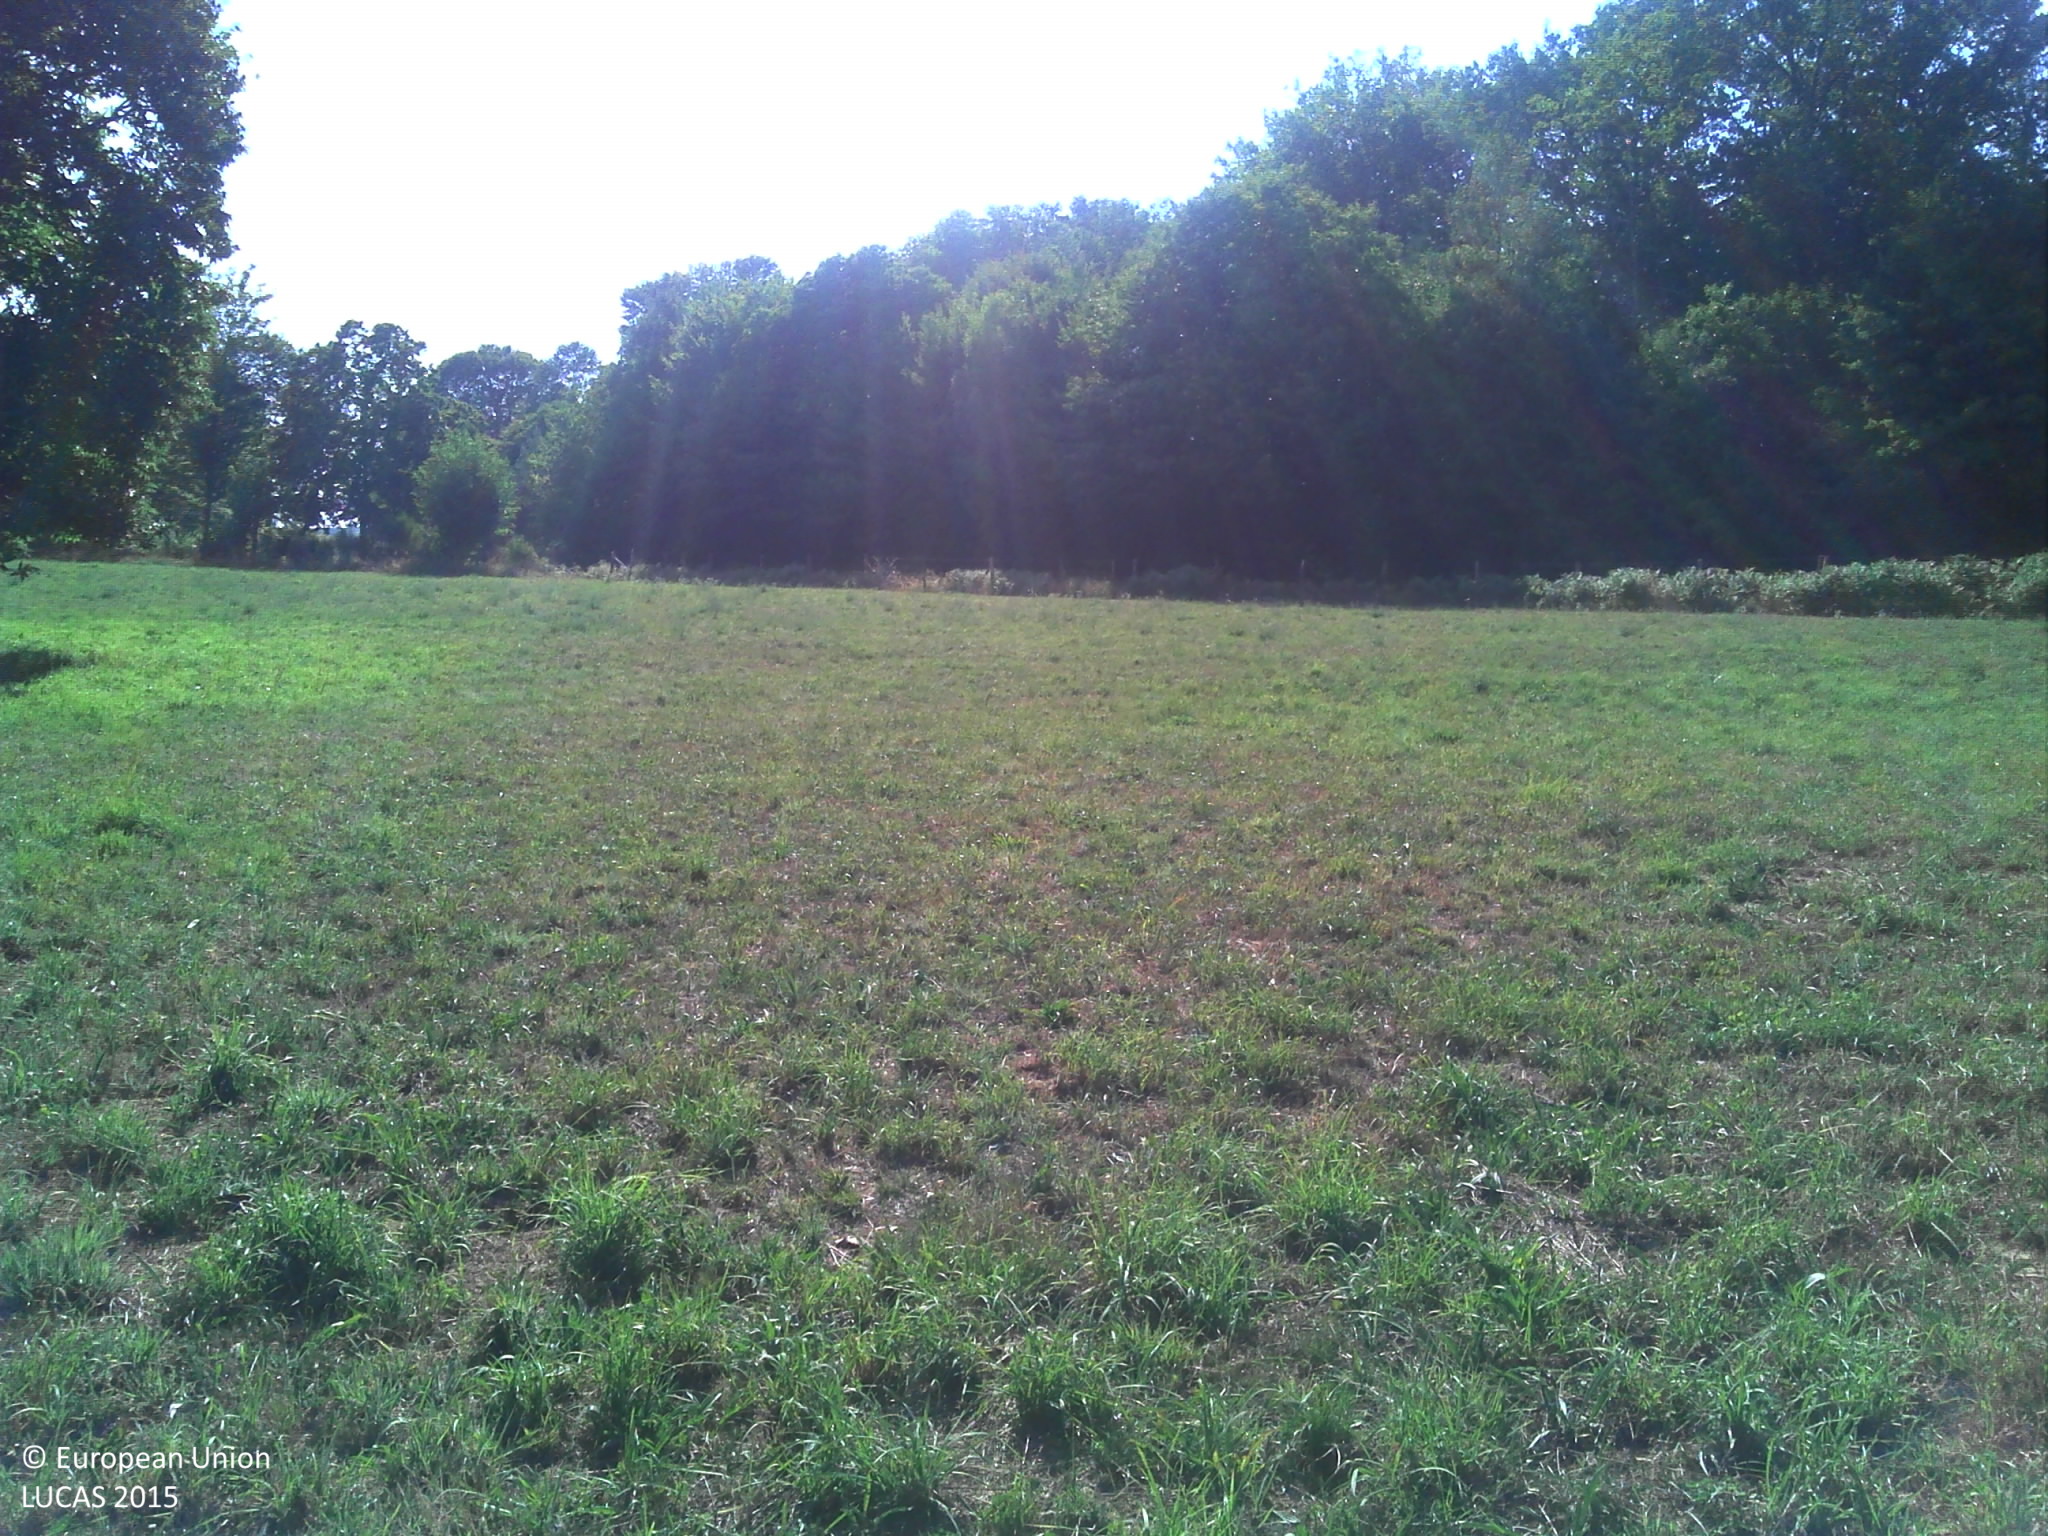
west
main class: Grassland
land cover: Grassland with sparse tree/shrub cover
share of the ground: > 75 %
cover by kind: herbaceous plants 85 %, shrubs 10 %, broadleaved forest trees 5 %
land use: Agriculture (excluding fallow land and kitchen gardens)
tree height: > 5 m
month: August
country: FR
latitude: 45.2497
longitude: 1.7012
